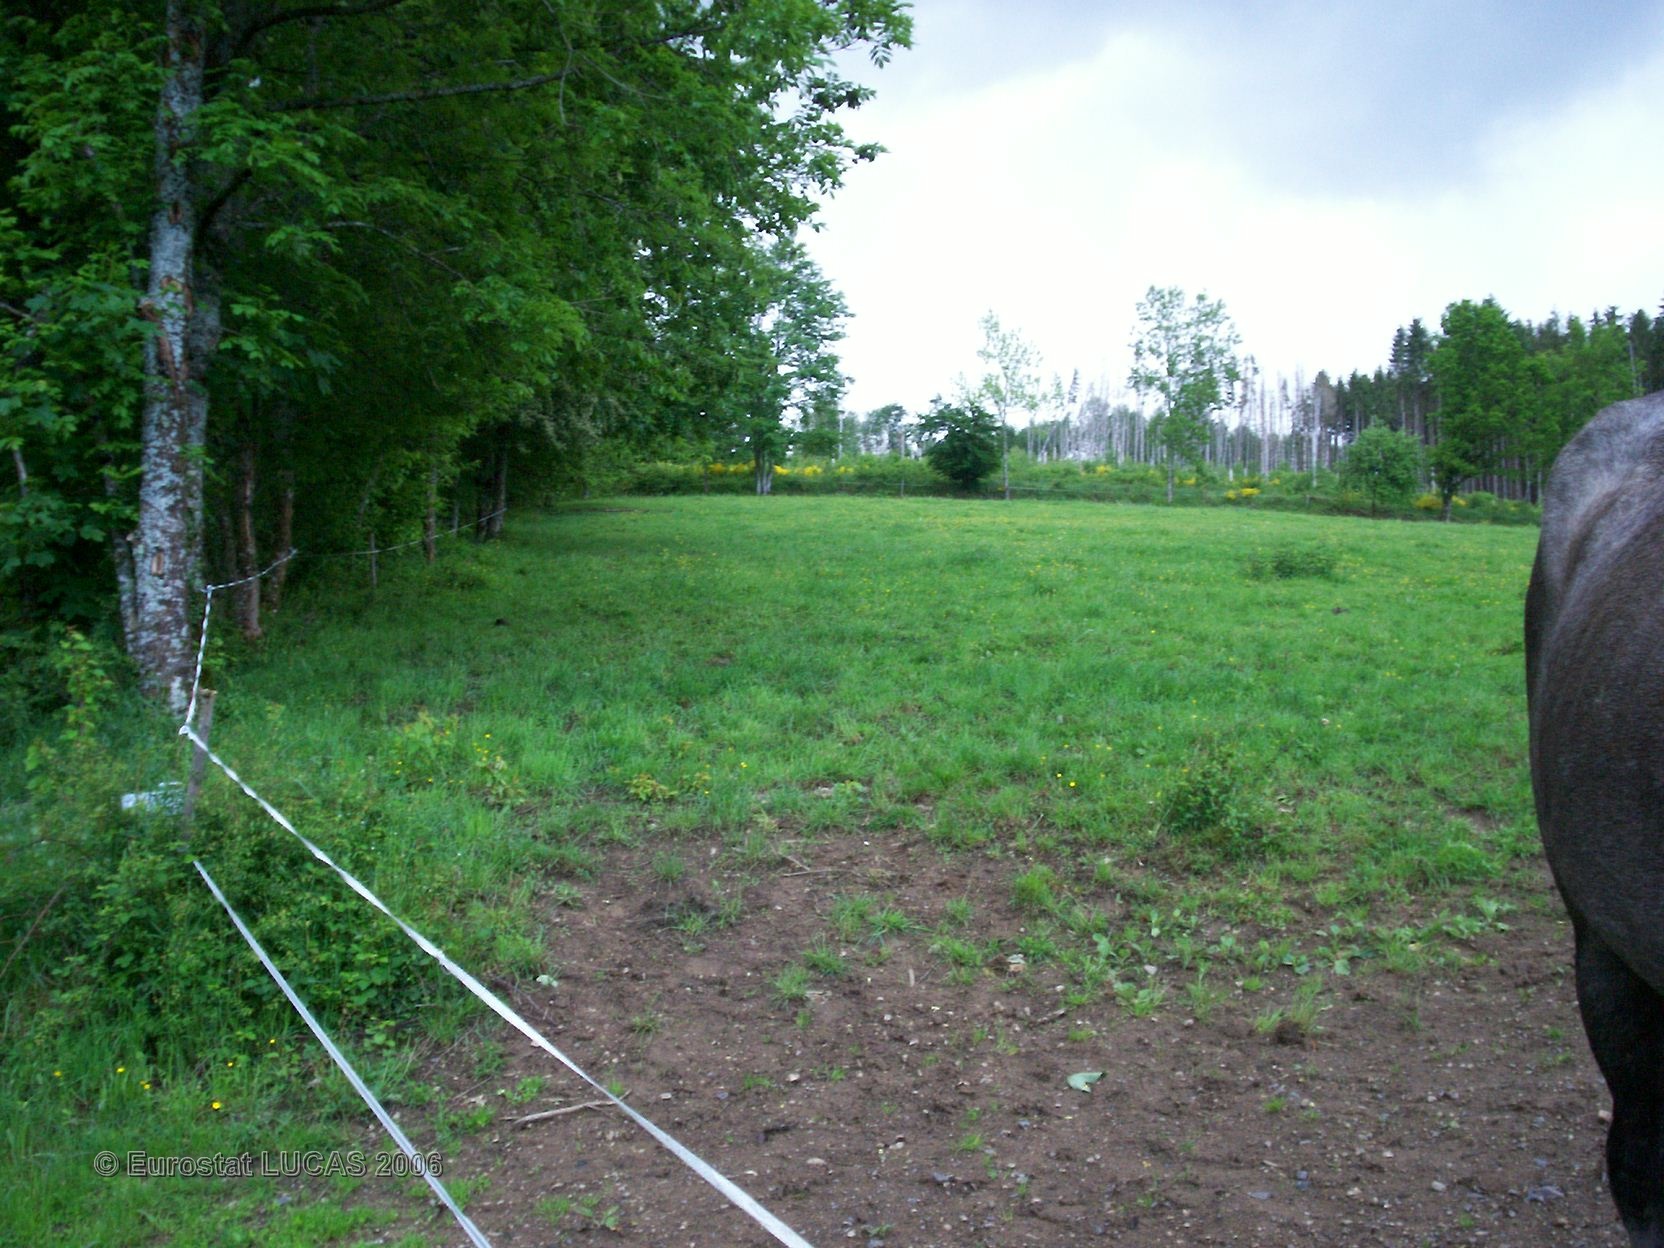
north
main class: Grassland
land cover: Grassland without tree/shrub cover
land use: Agriculture (excluding fallow land and kitchen gardens)
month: May
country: FR
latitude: 48.2935
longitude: 7.1029
